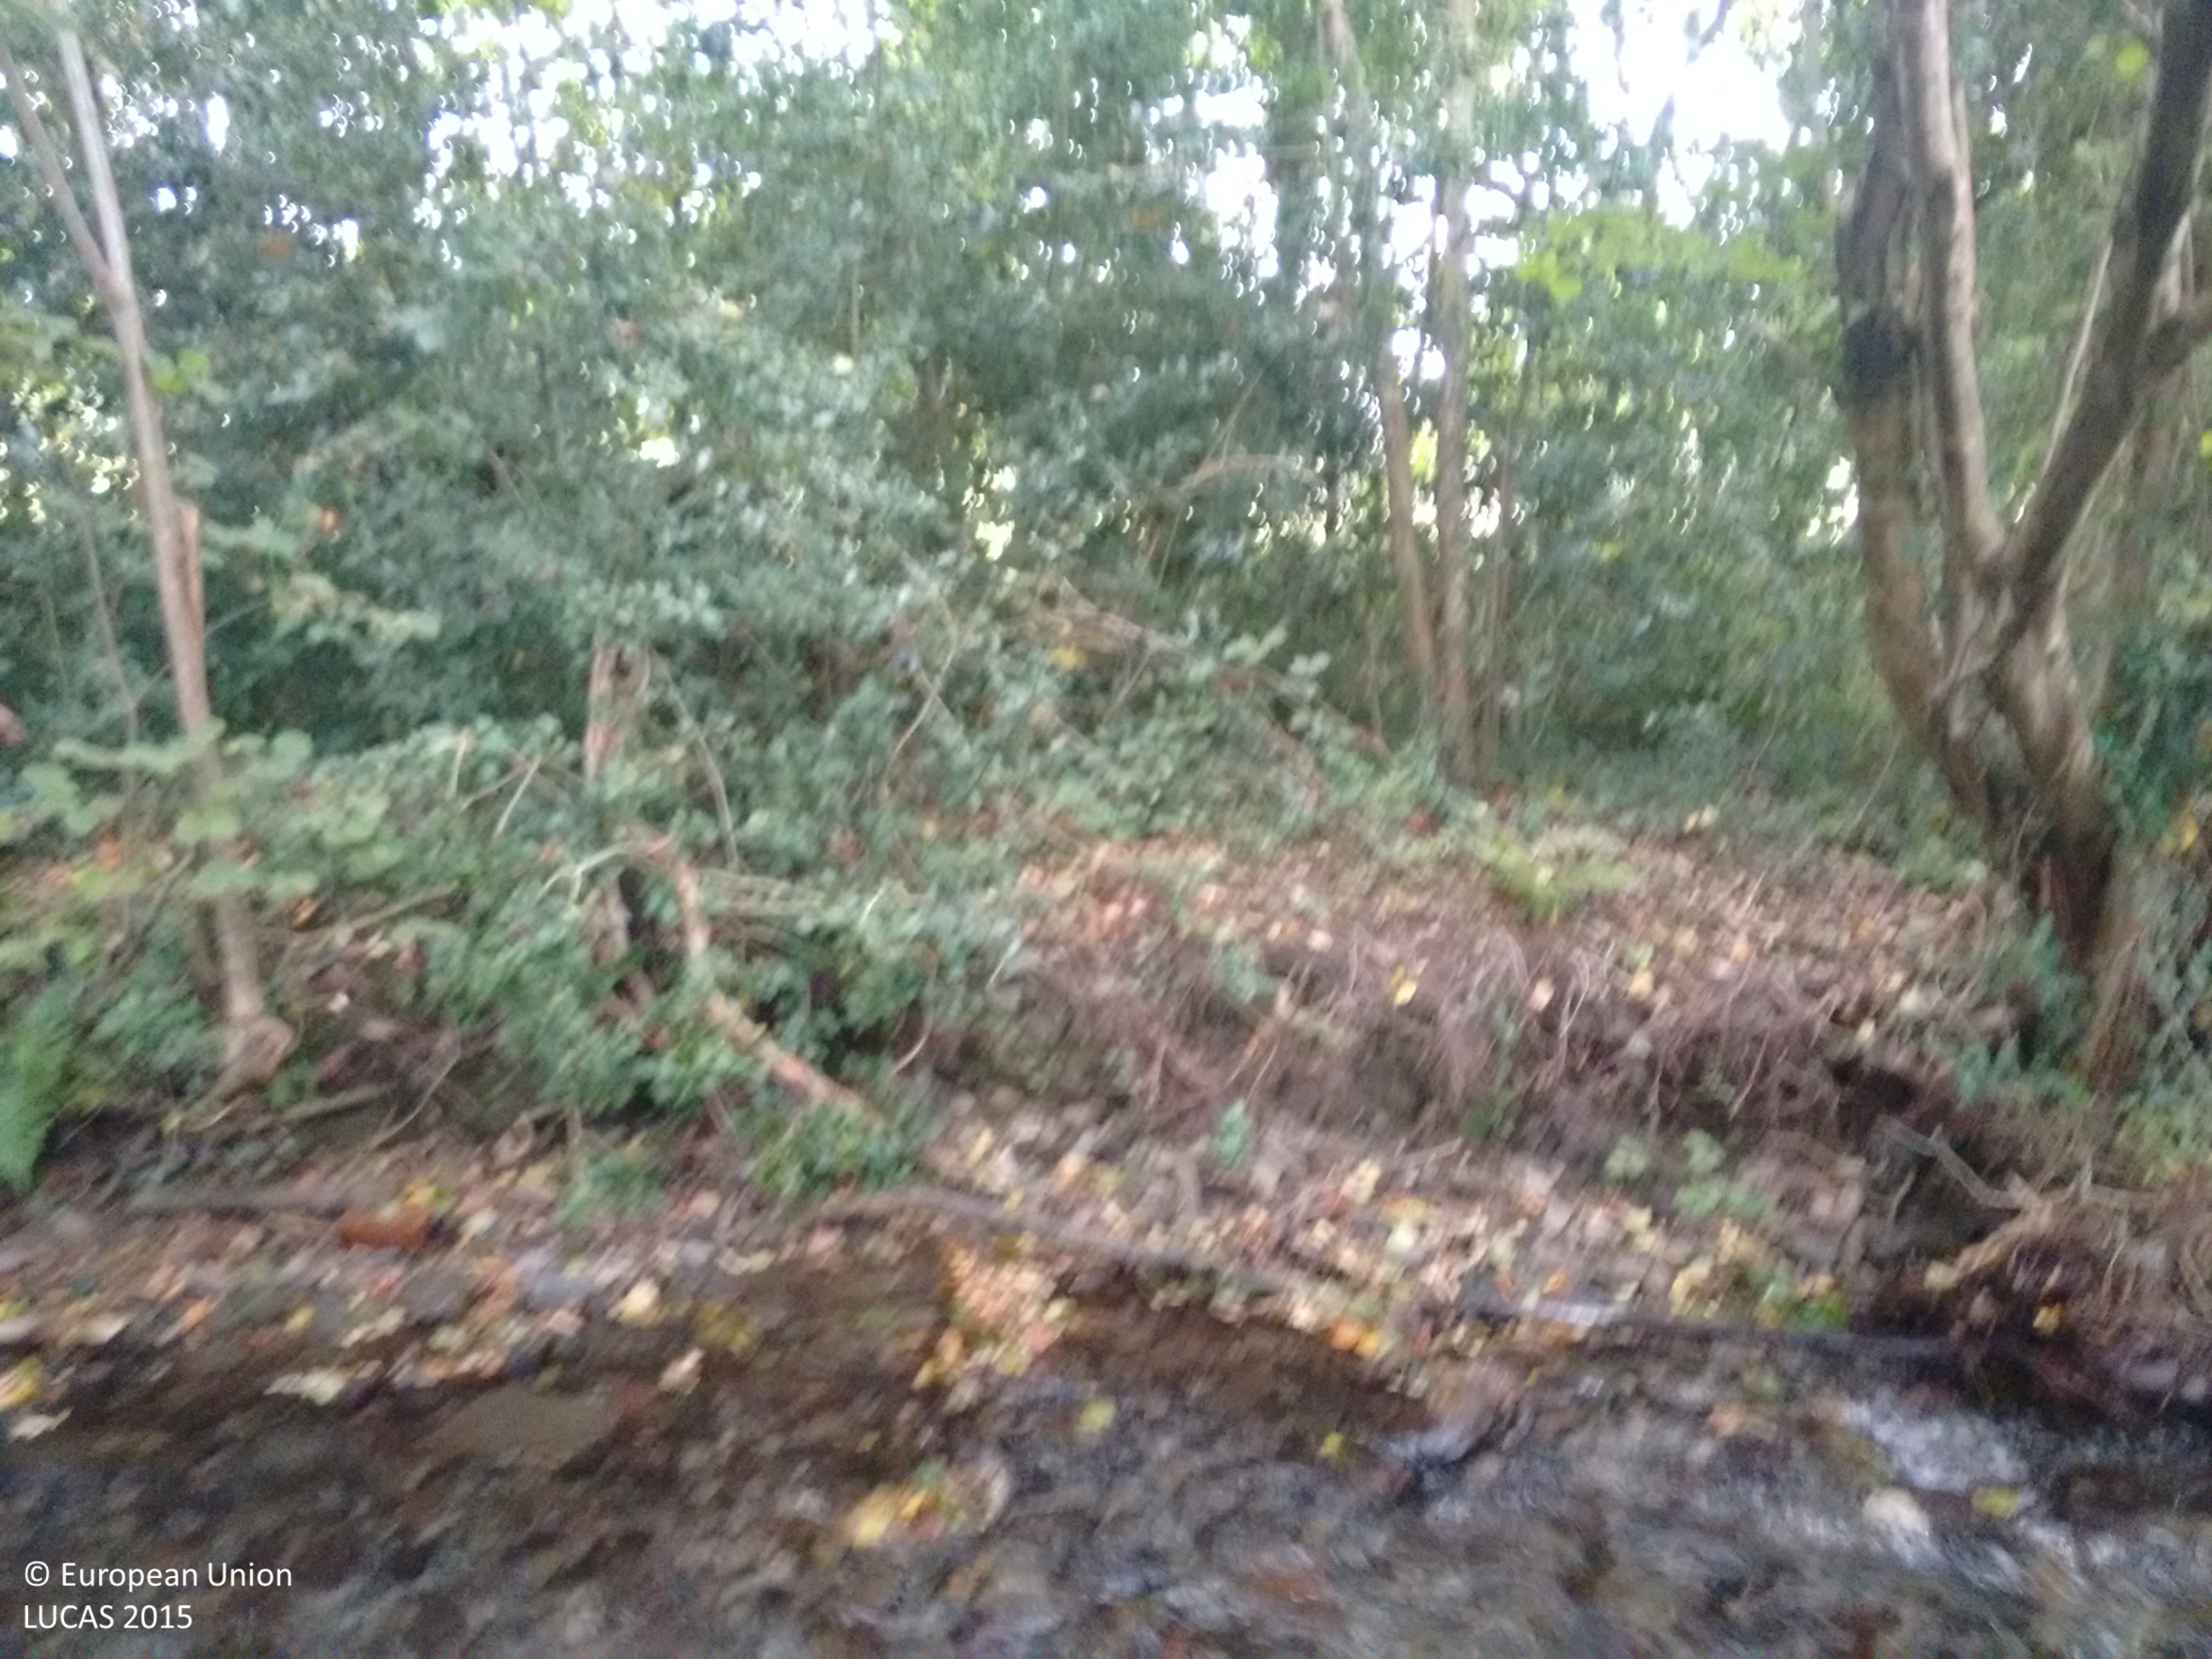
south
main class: Woodland
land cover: Broadleaved woodland
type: mesophytic deciduous forest
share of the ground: > 75 %
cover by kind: broadleaved forest trees 100 %
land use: Semi-natural and natural areas not in use
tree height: > 5 m
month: October
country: GB
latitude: 52.4376
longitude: -3.9953
